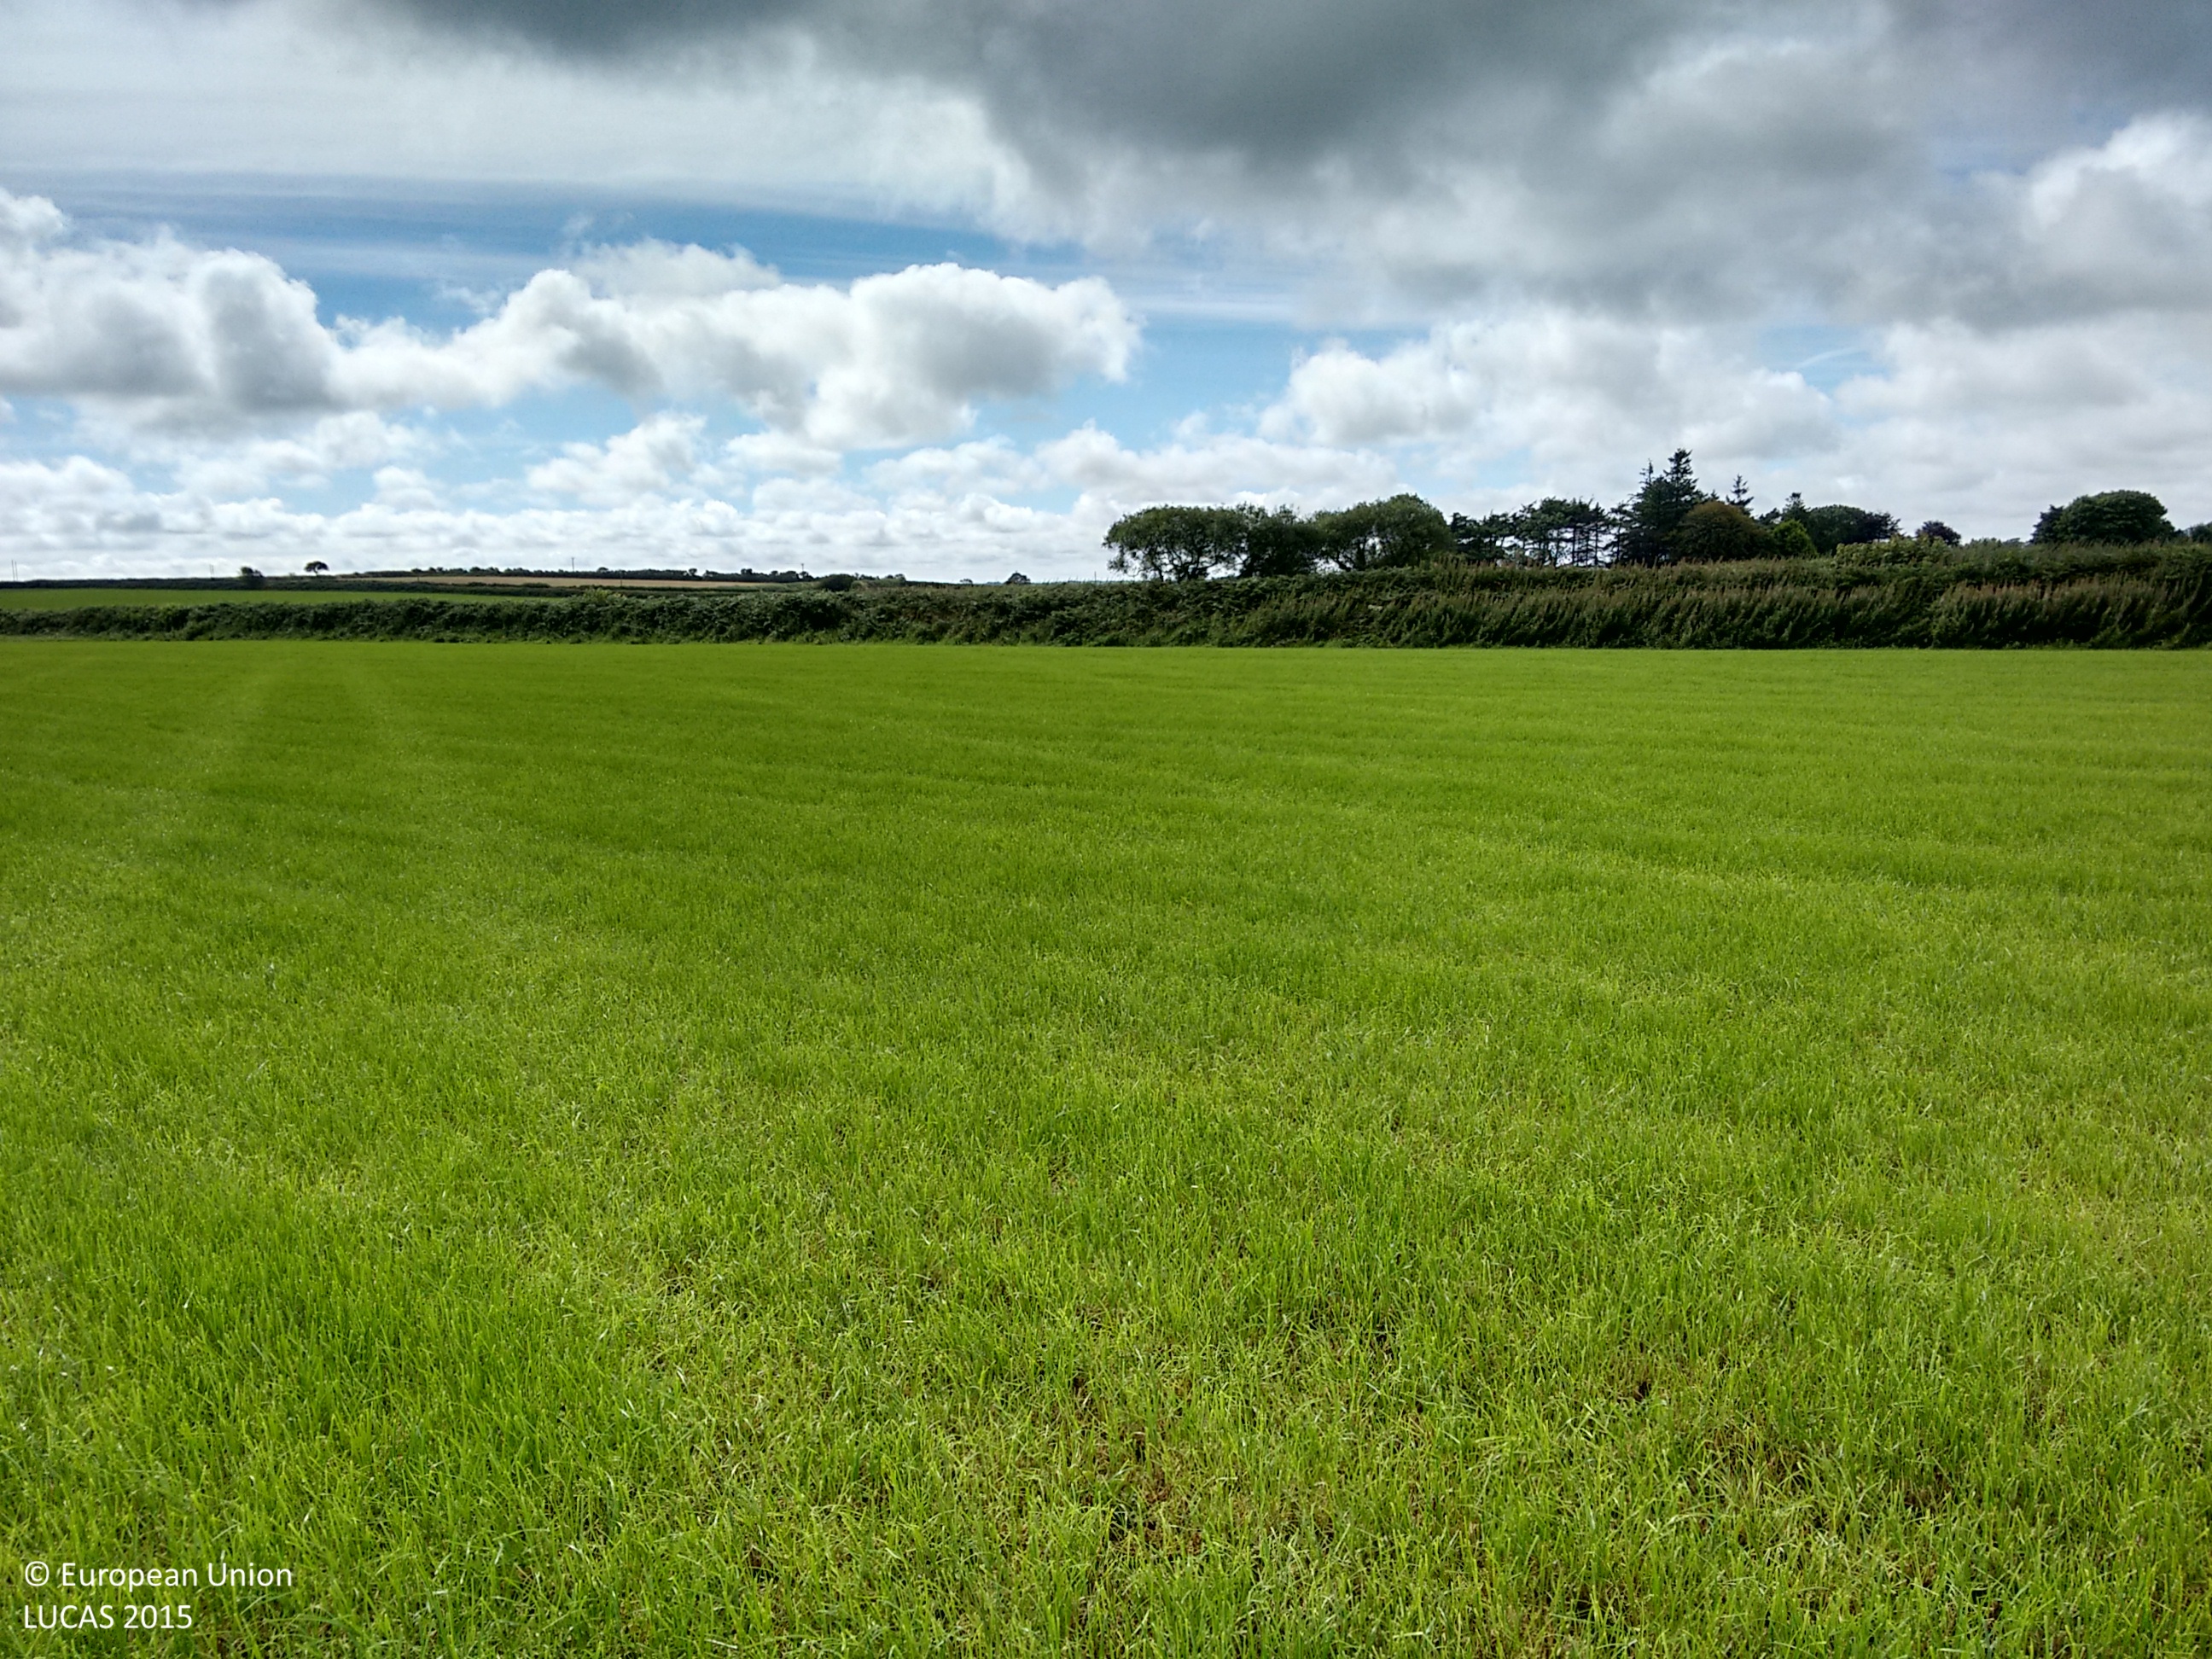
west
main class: Cropland
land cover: Temporary grasslands
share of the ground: > 75 %
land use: Agriculture (excluding fallow land and kitchen gardens)
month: August
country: GB
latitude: 51.9022
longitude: -4.9256
